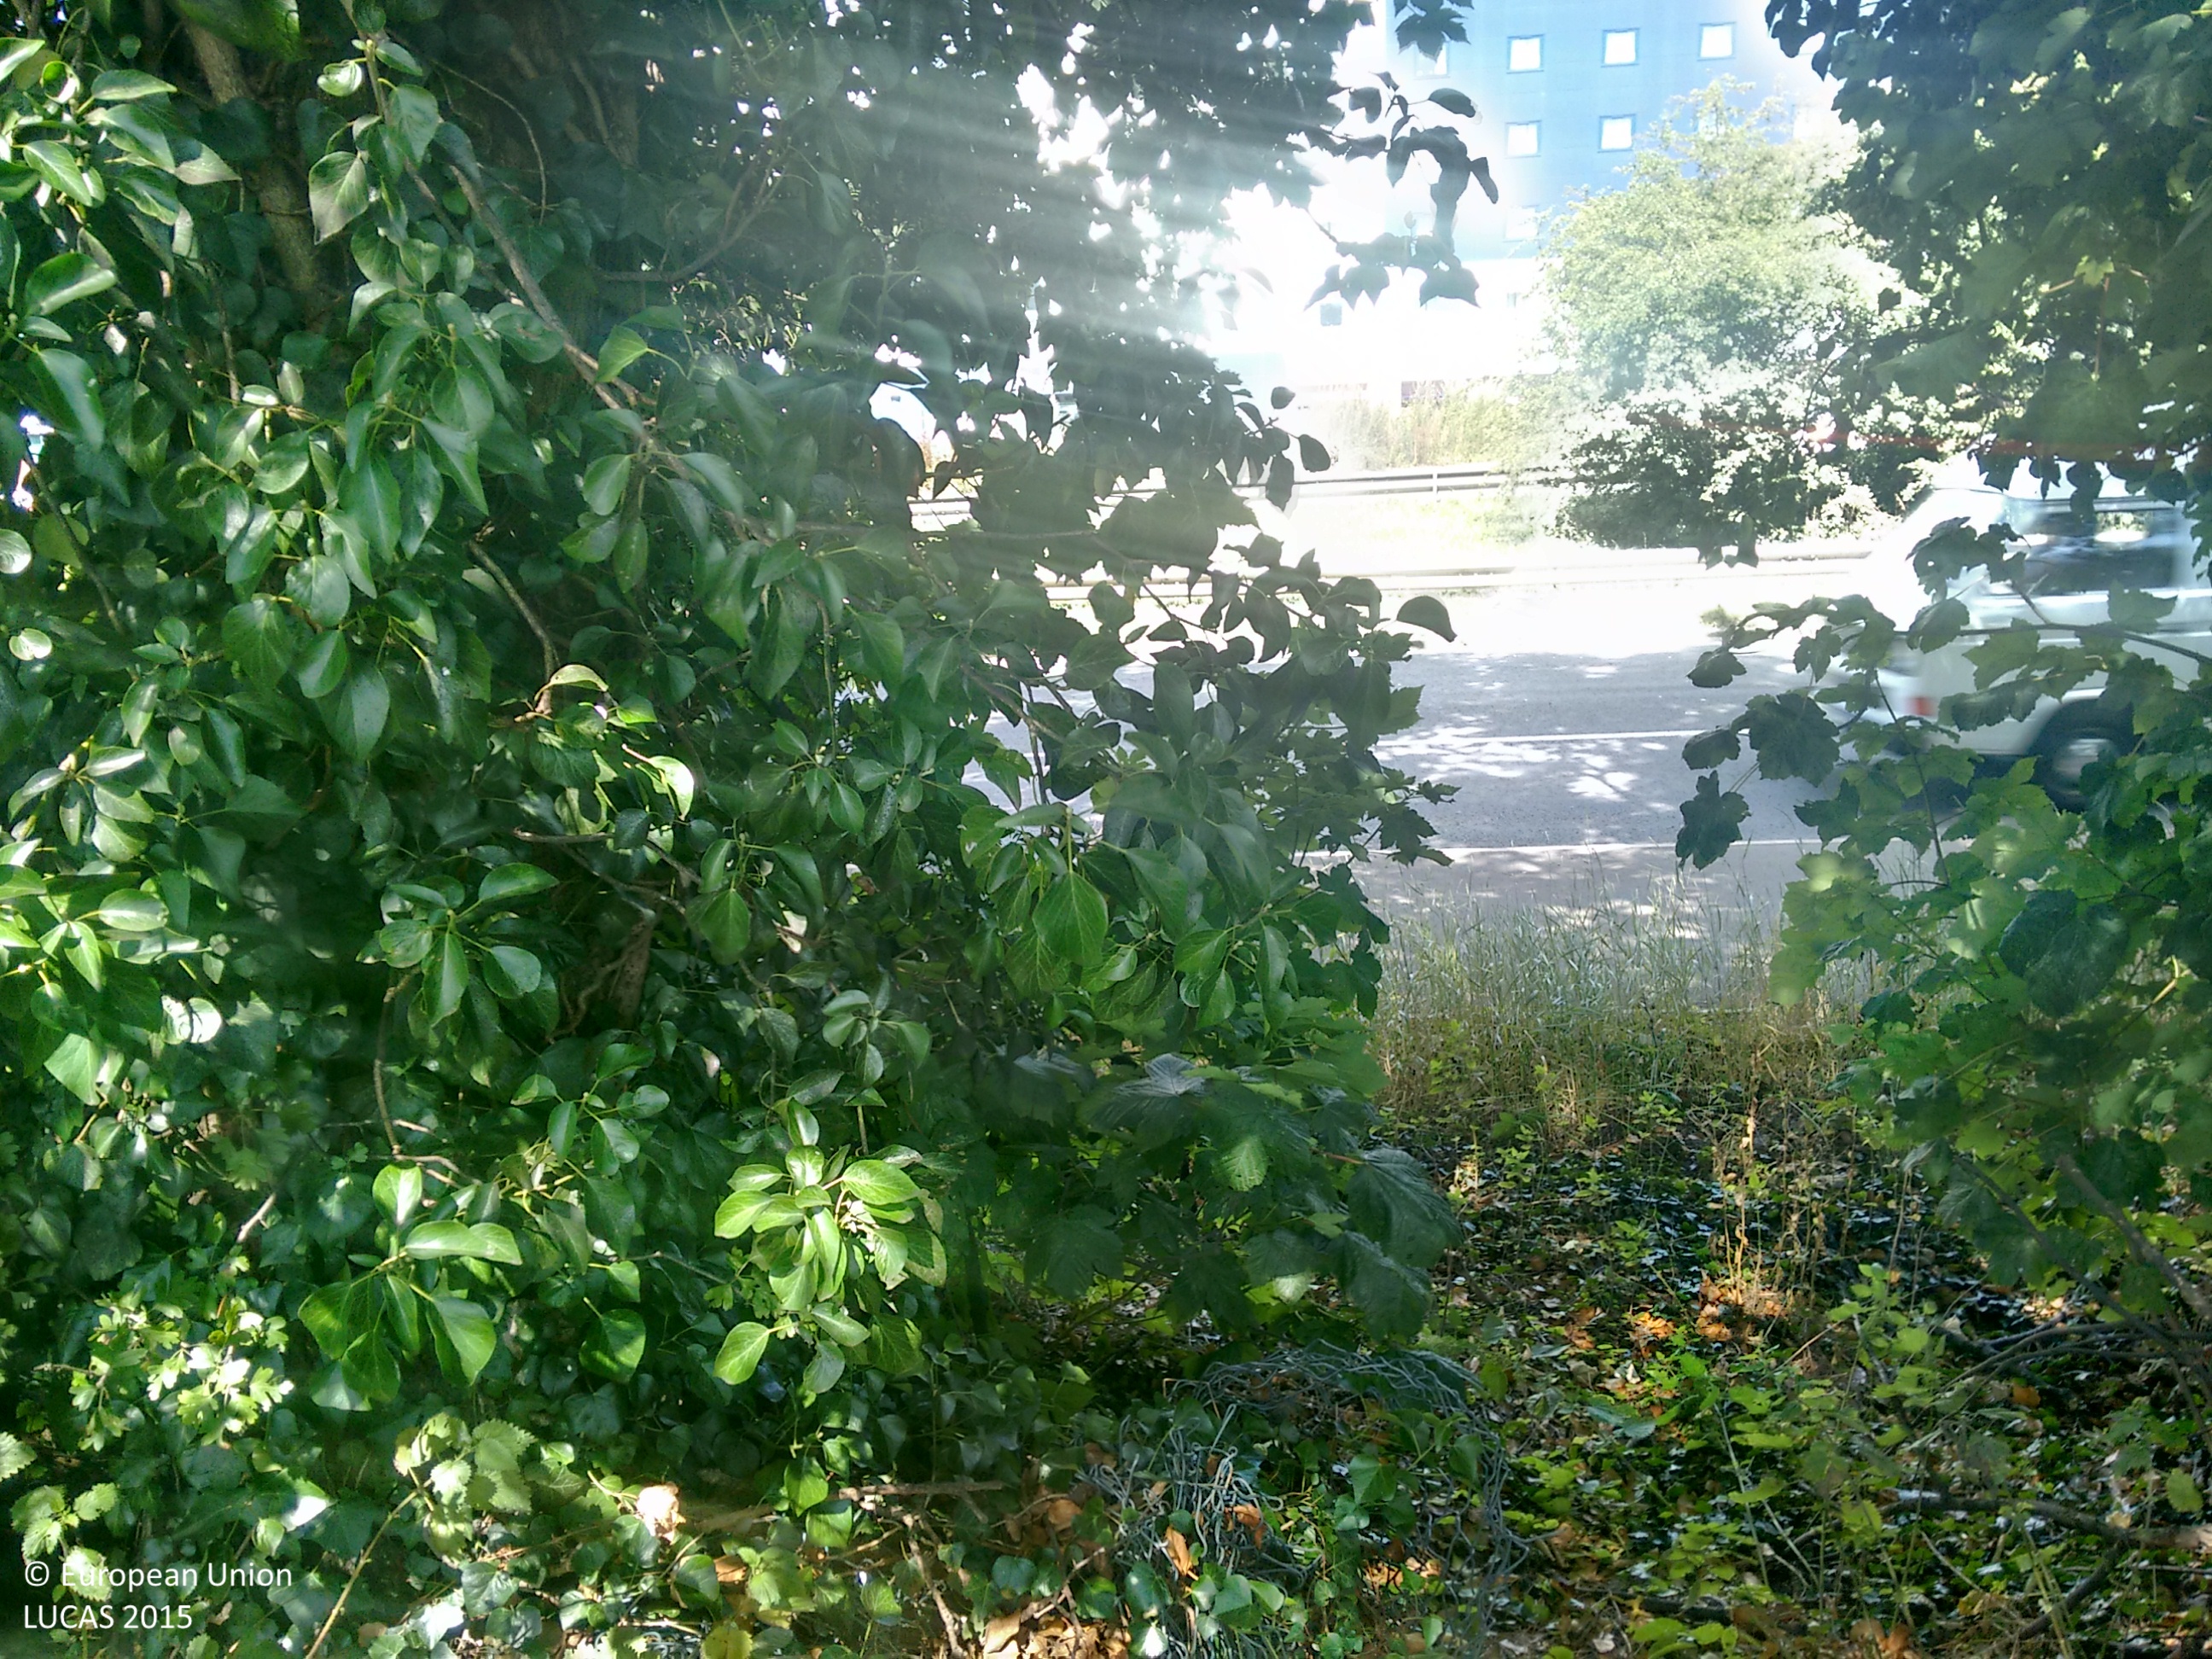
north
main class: Grassland
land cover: Grassland without tree/shrub cover
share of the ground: > 75 %
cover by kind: herbaceous plants 100 %
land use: Semi-natural and natural areas not in use
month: July
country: GB
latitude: 52.4457
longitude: -1.7511
